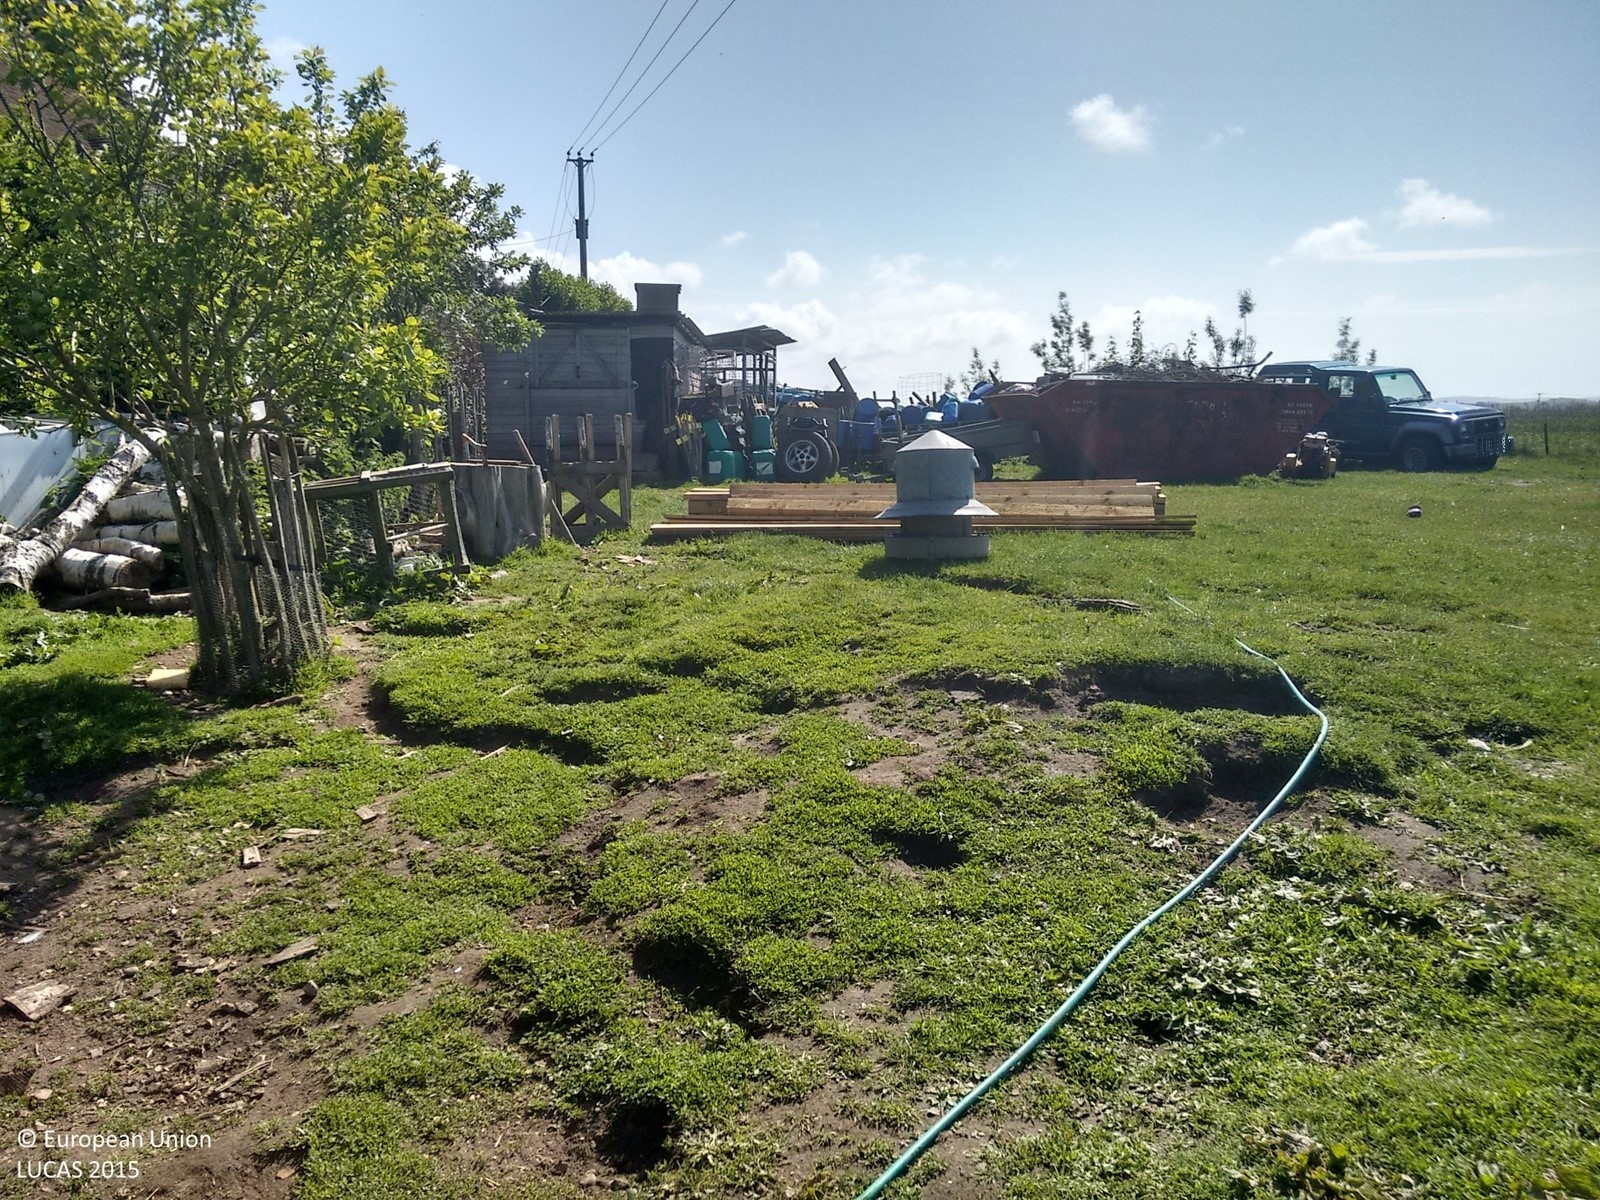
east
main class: Grassland
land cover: Grassland with sparse tree/shrub cover
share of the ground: > 75 %
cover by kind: herbaceous plants 95 %, broadleaved forest trees 5 %
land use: Agriculture (excluding fallow land and kitchen gardens)
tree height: < 5 m
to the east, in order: Grassland with sparse tree/shrub cover; Artificial constructions in urban areas; Grass margins; Grassland without tree/shrub cover
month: May
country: GB
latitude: 50.6851
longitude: -2.2484
